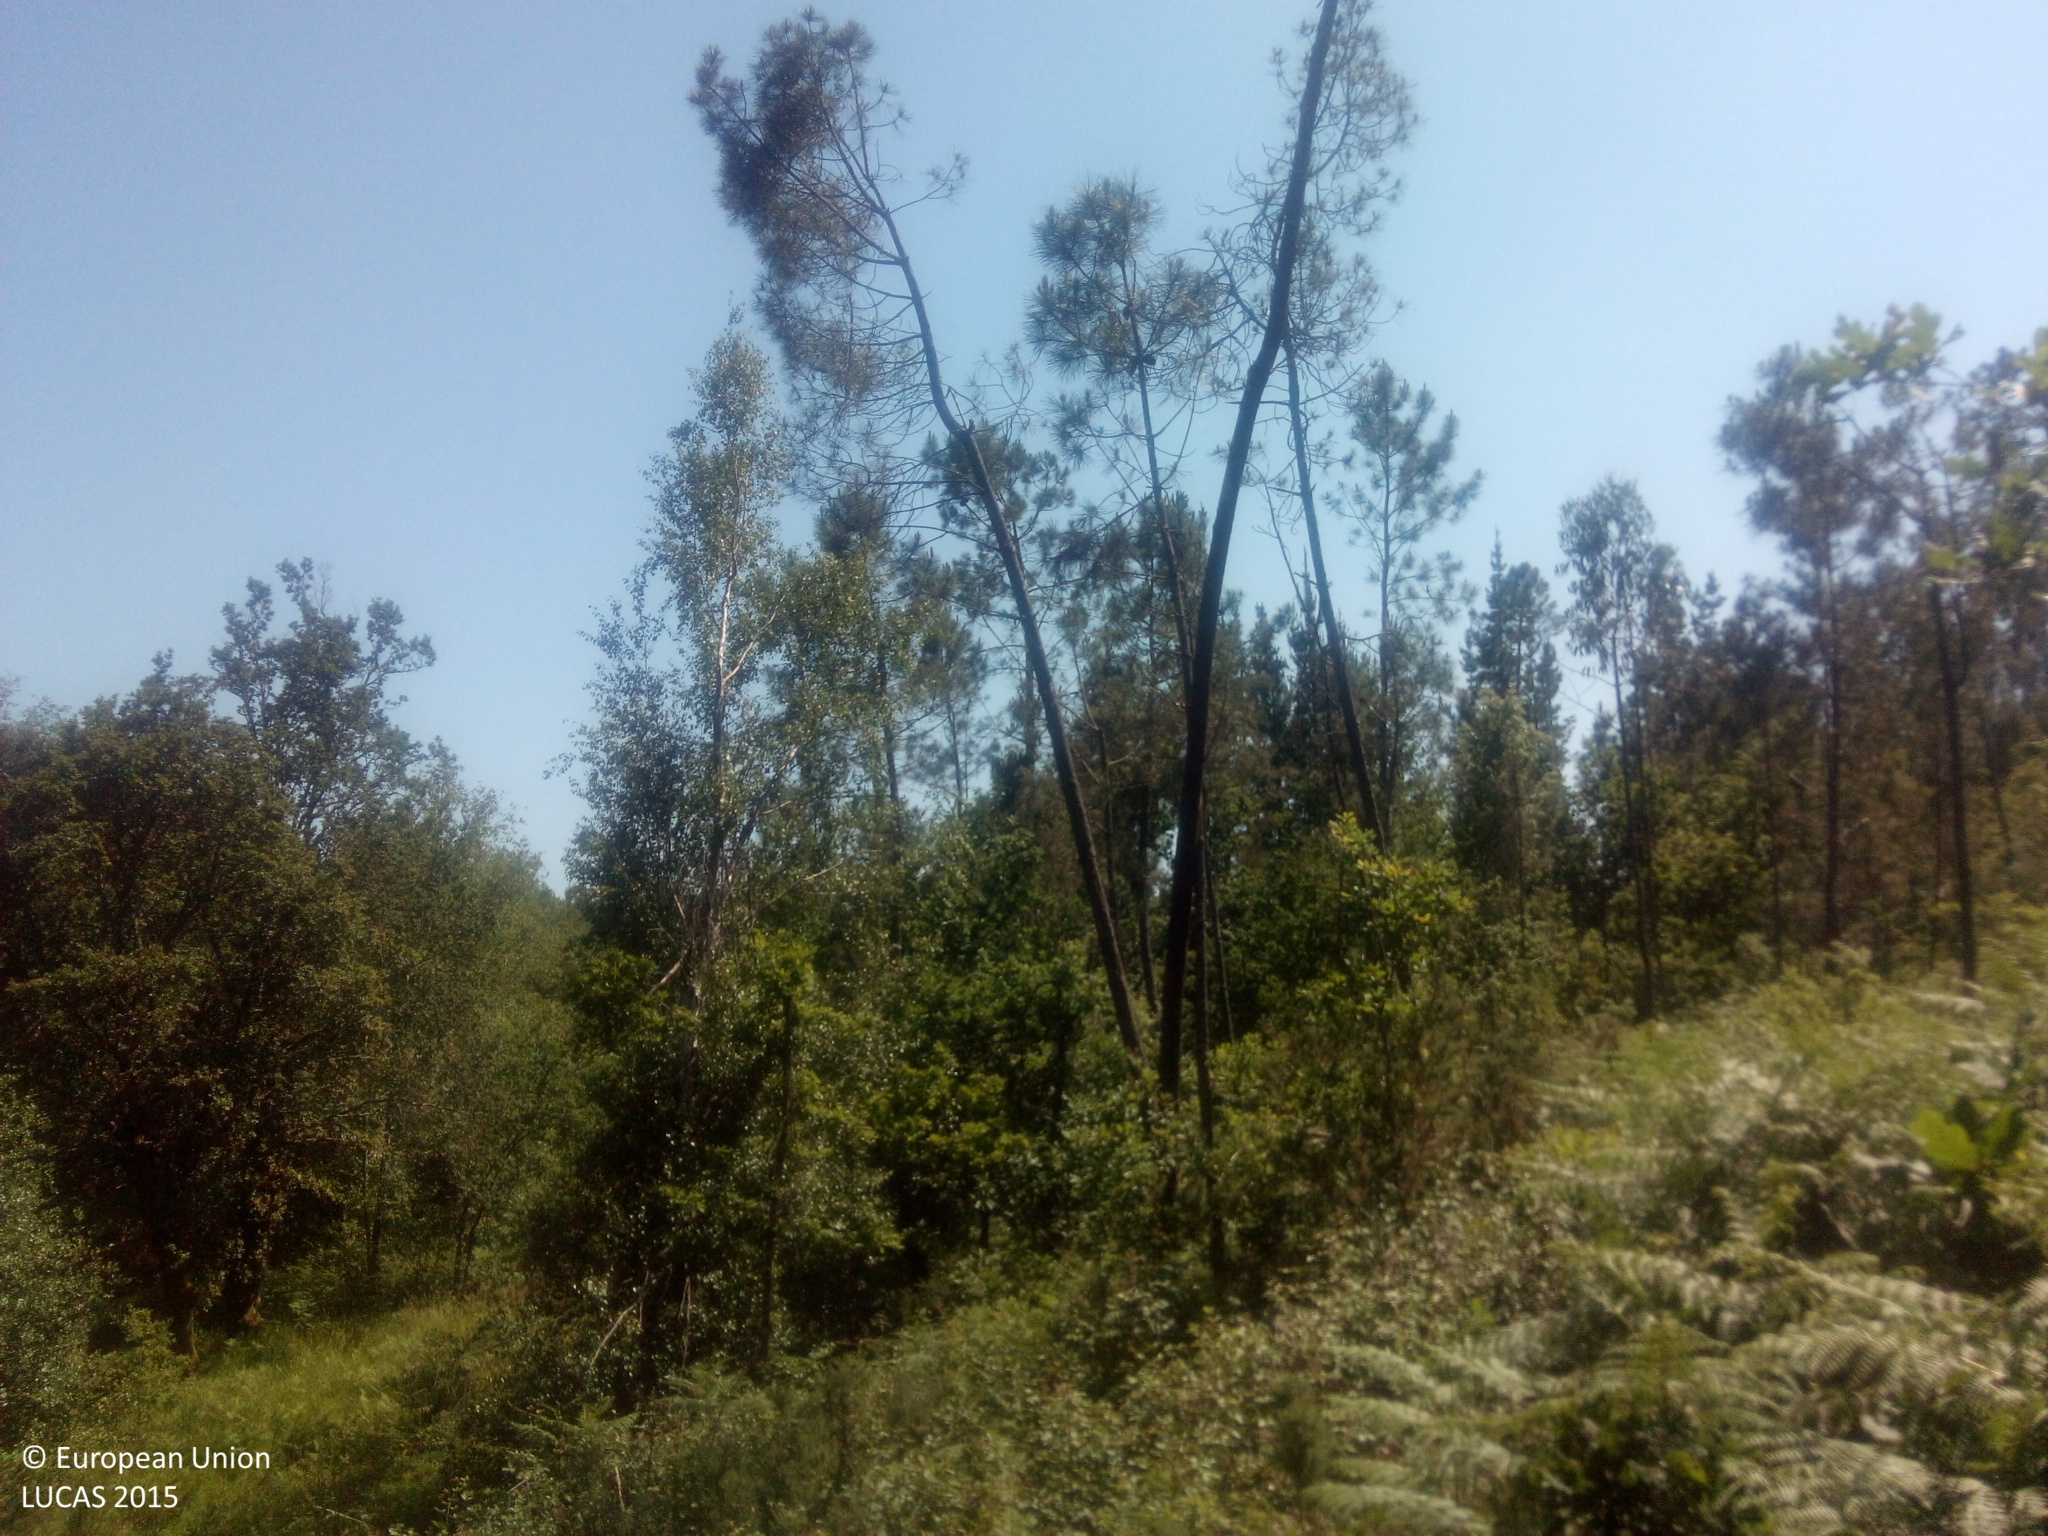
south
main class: Woodland
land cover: Pine dominated coniferous woodland
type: exotic forest
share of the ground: > 75 %
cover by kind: coniferous forest trees 75 %, shrubs 25 %
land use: Forestry
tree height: > 5 m
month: June
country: ES
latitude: 42.2087
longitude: -8.2928
